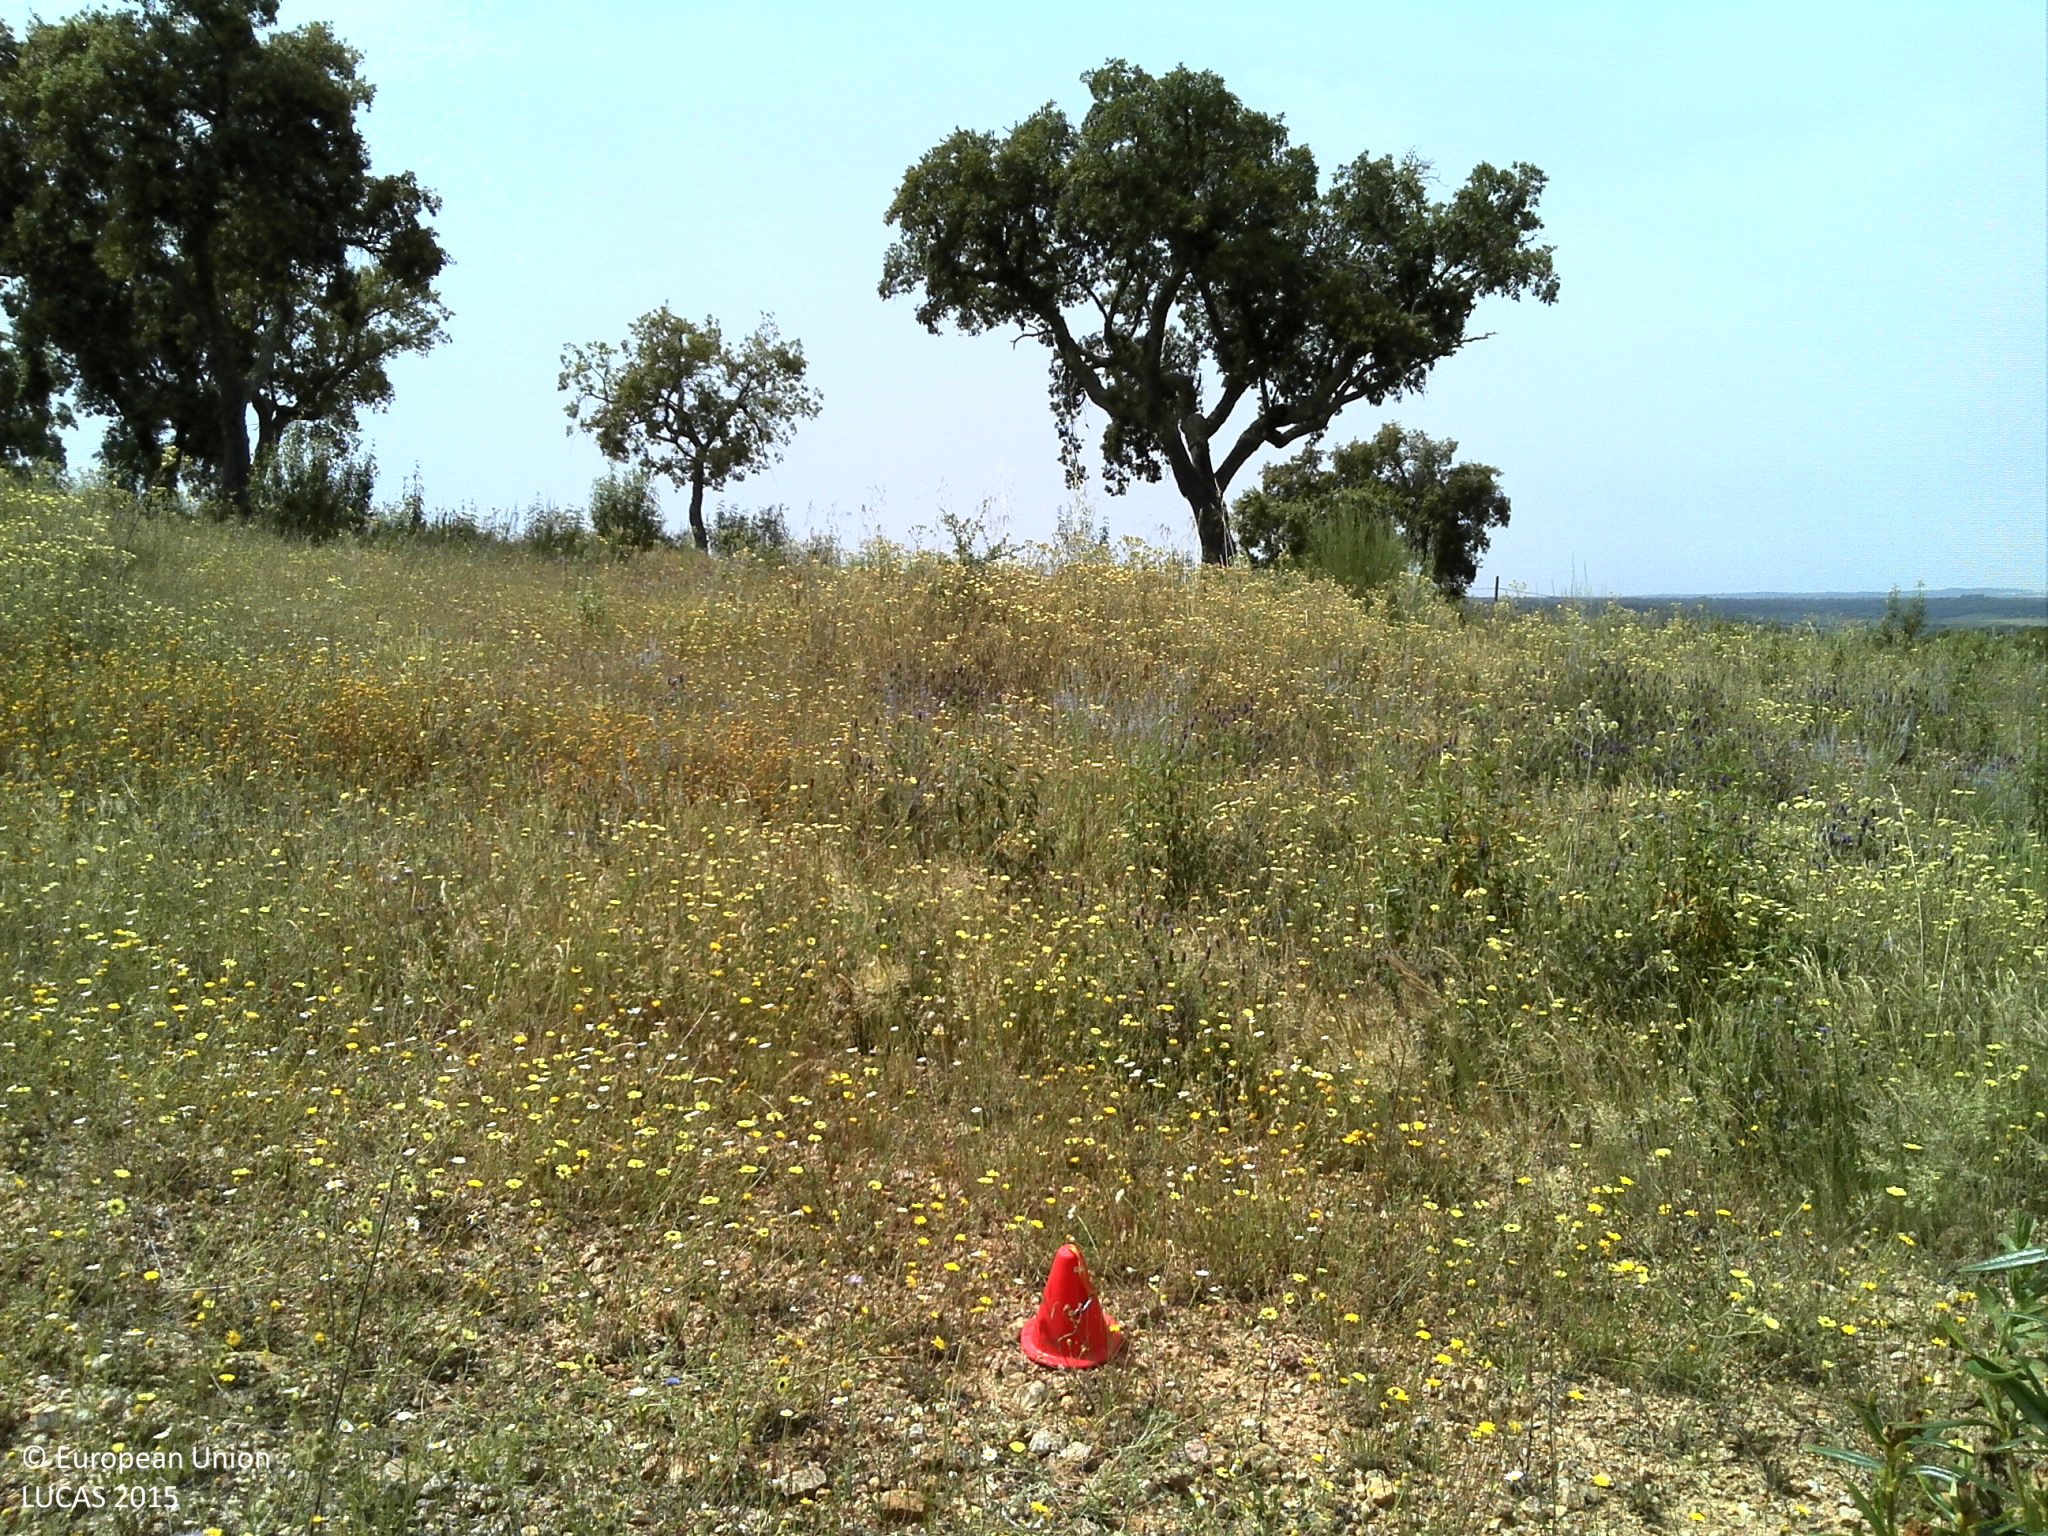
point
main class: Woodland
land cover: Broadleaved woodland
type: broadleaved evergreen forest
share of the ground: 10 - 25 %
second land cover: Grassland without tree/shrub cover
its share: 10 - 25 %
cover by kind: herbaceous plants 30 %, unconsolidated bare surface 30 %, shrubs 25 %, broadleaved forest trees 15 %
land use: Forestry
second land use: Agriculture (excluding fallow land and kitchen gardens)
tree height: > 5 m
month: May
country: PT
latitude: 39.0058
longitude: -7.9357
